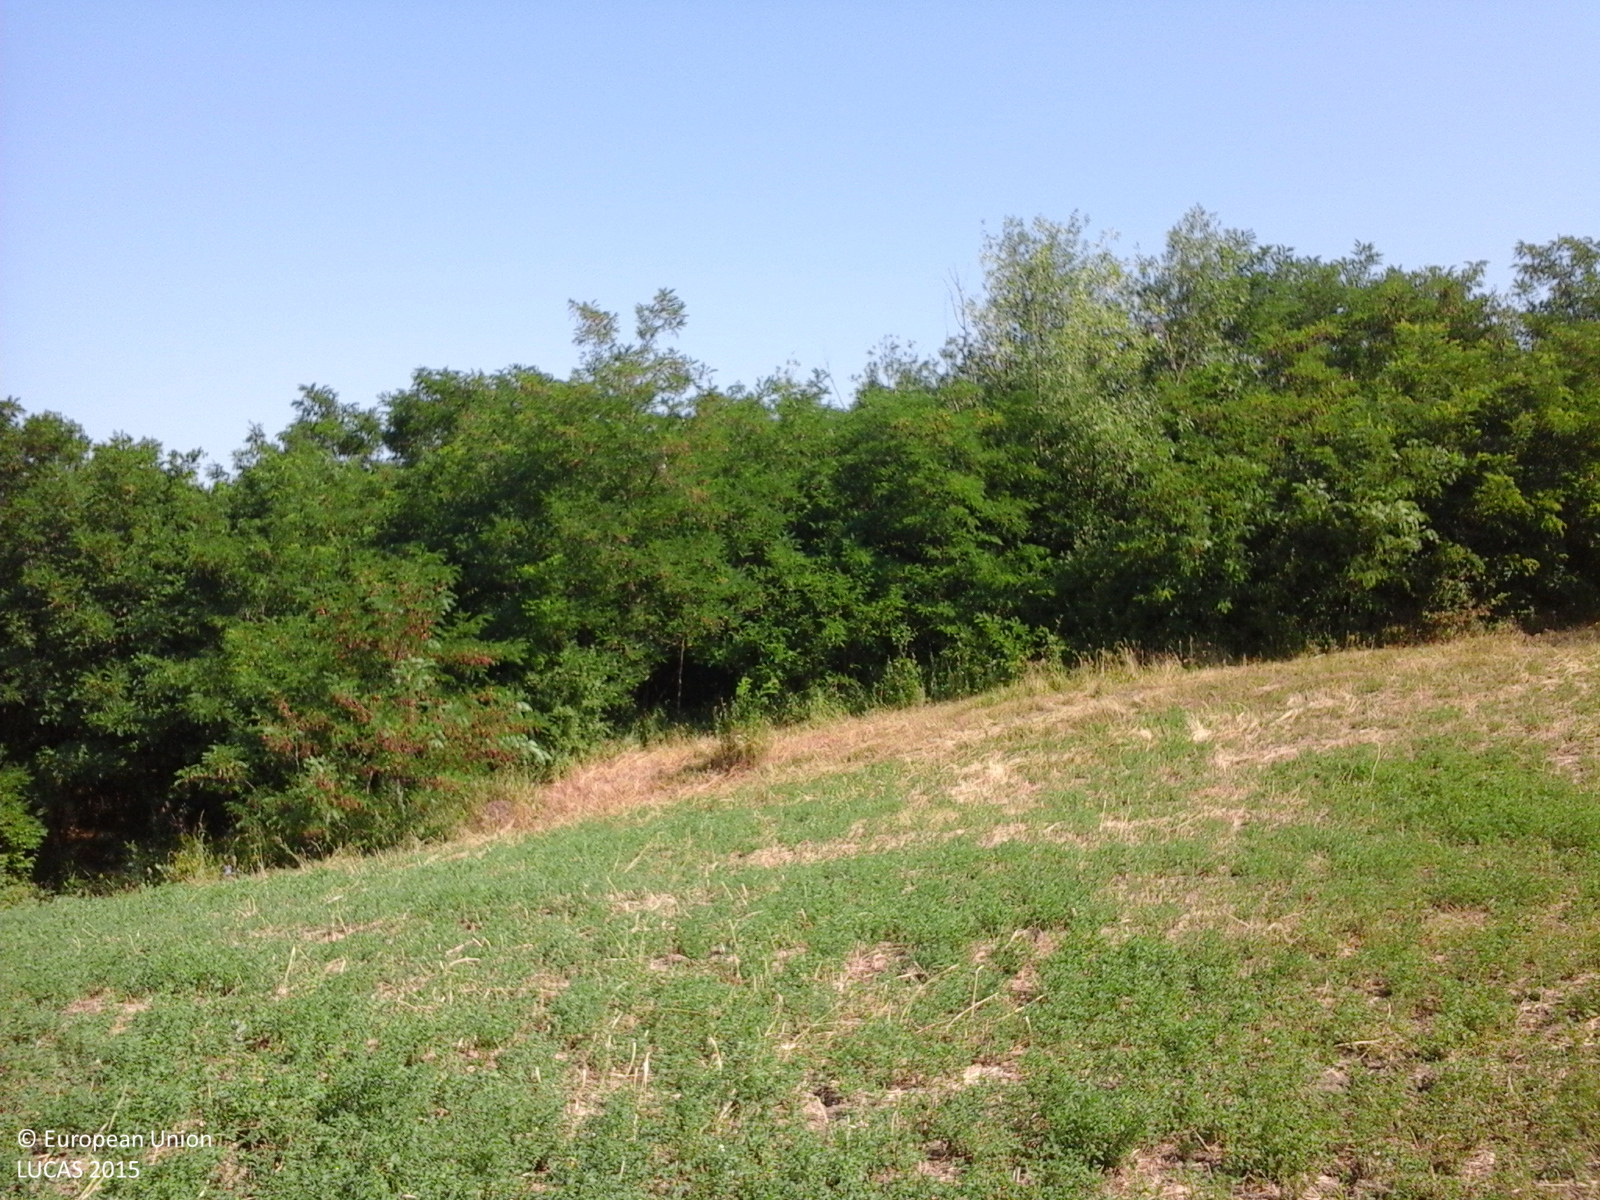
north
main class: Cropland
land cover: Lucerne
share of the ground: < 10 %
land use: Agriculture (excluding fallow land and kitchen gardens)
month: June
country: RO
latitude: 46.9792
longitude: 27.8055
